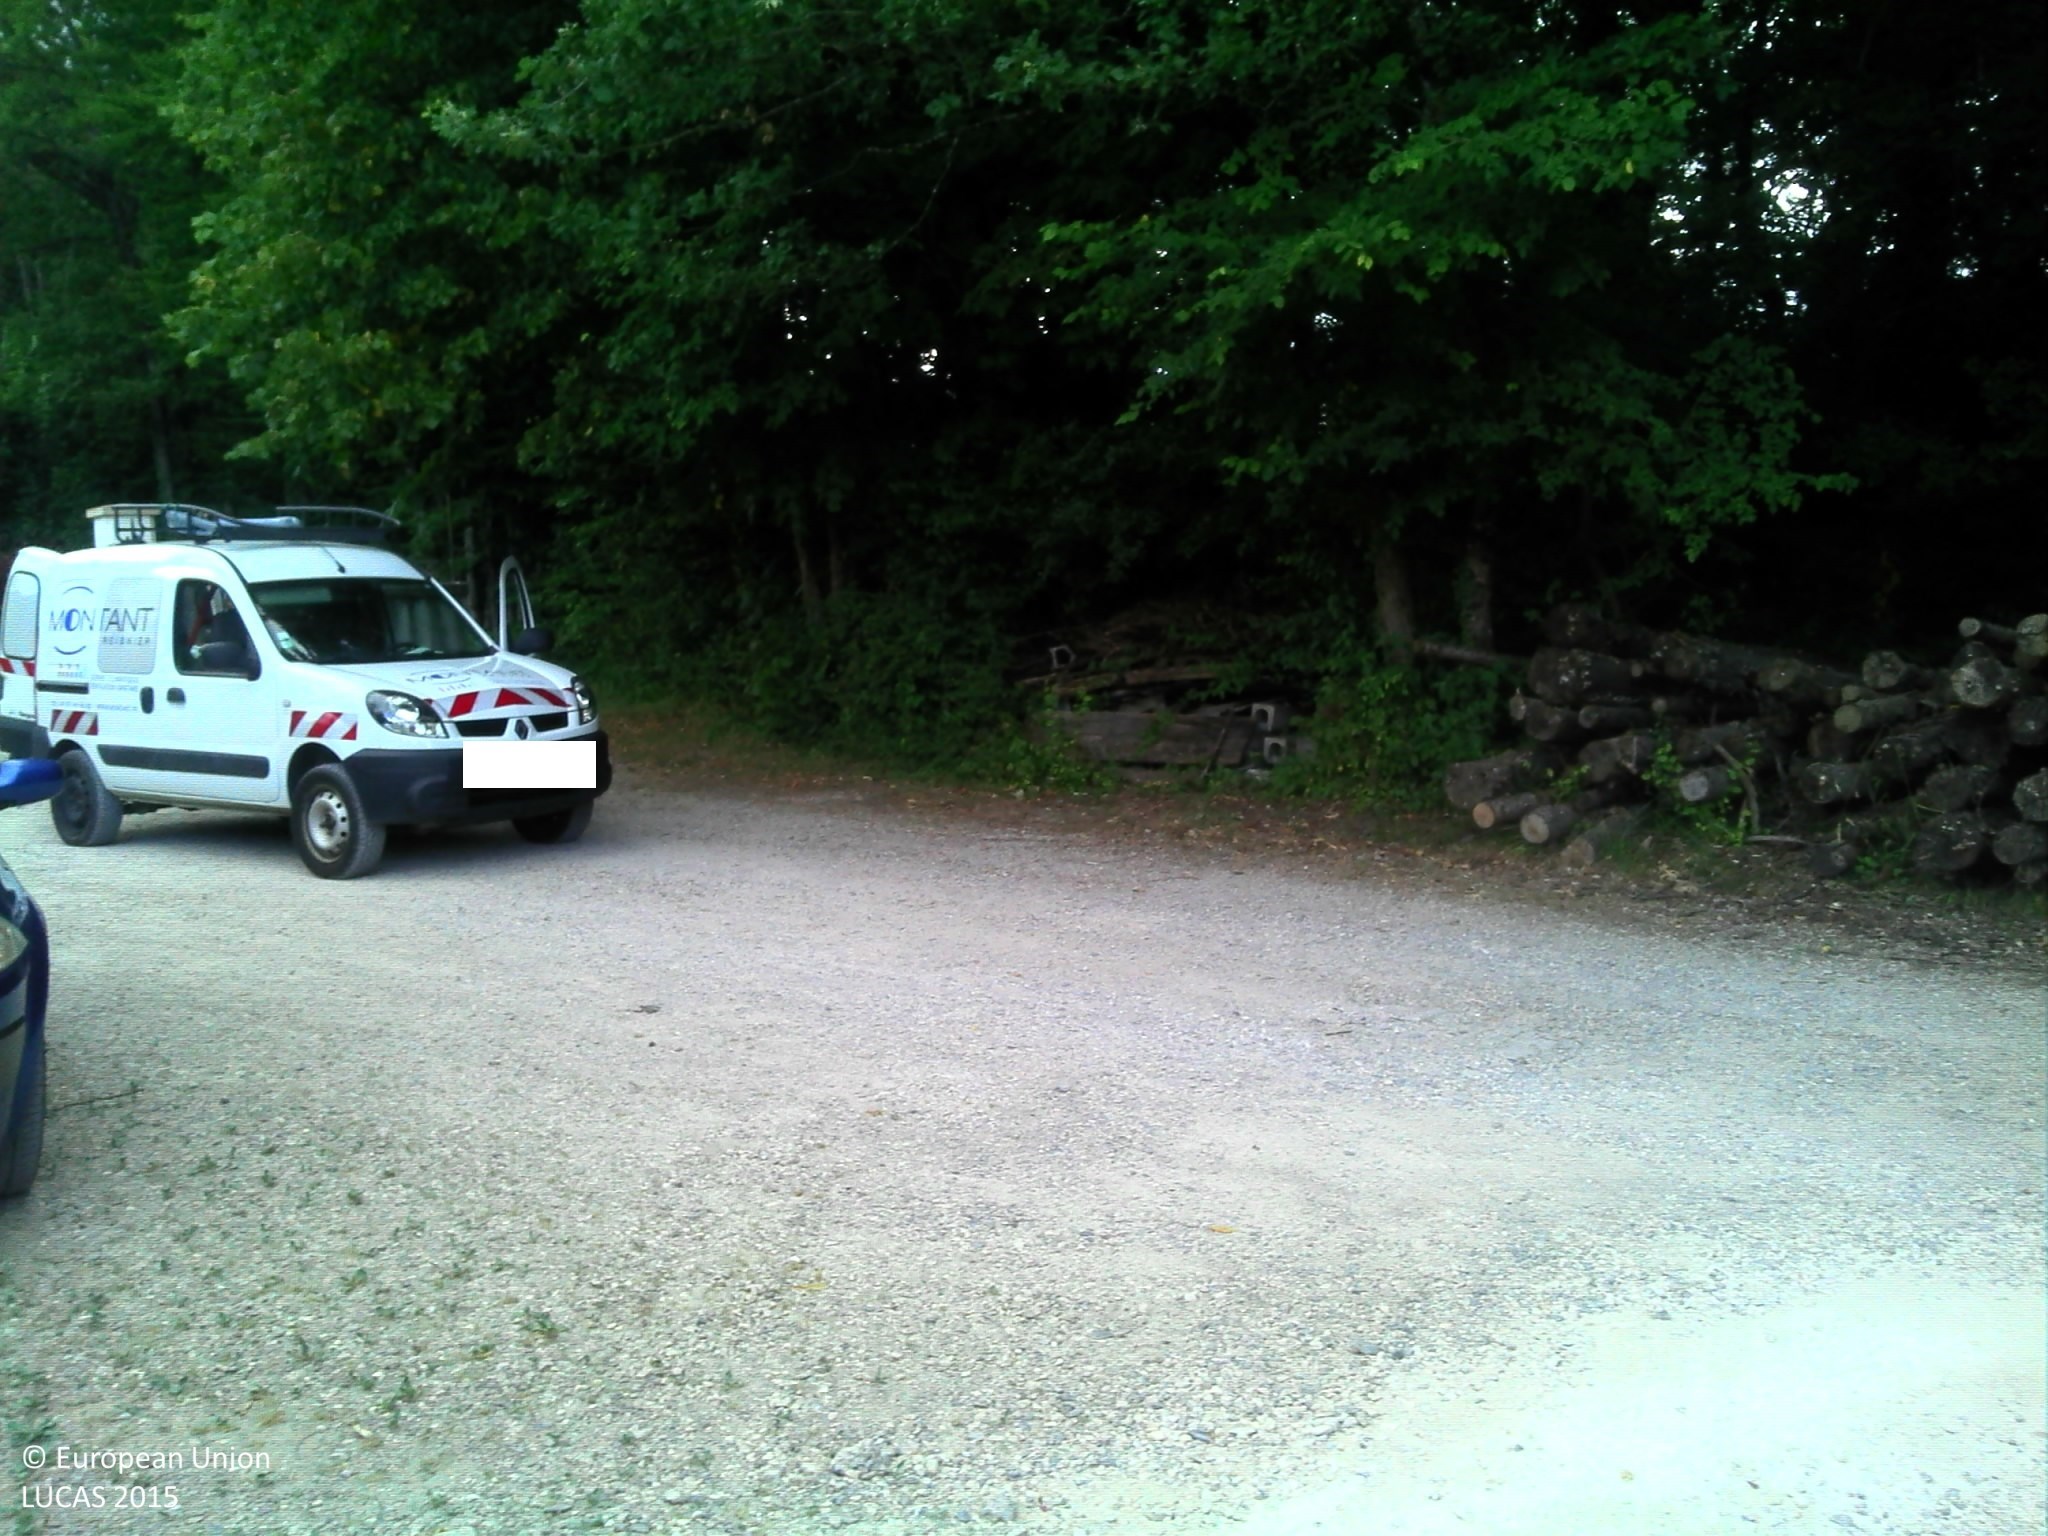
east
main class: Grassland
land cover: Grassland with sparse tree/shrub cover
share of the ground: > 75 %
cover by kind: herbaceous plants 95 %, broadleaved forest trees 5 %
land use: Residential
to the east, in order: Grassland with sparse tree/shrub cover; Fences; Paved roads, cycling and walking lanes; Broadleaved woodland; Tracks; Broadleaved woodland; Spontaneously vegetated surfaces; Other bare soil; Grassland without tree/shrub cover; Ditches and canals; Paved roads, cycling and walking lanes; Grassland without tree/shrub cover; Electric lines; Broadleaved woodland
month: July
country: FR
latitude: 46.1606
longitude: 6.2869
